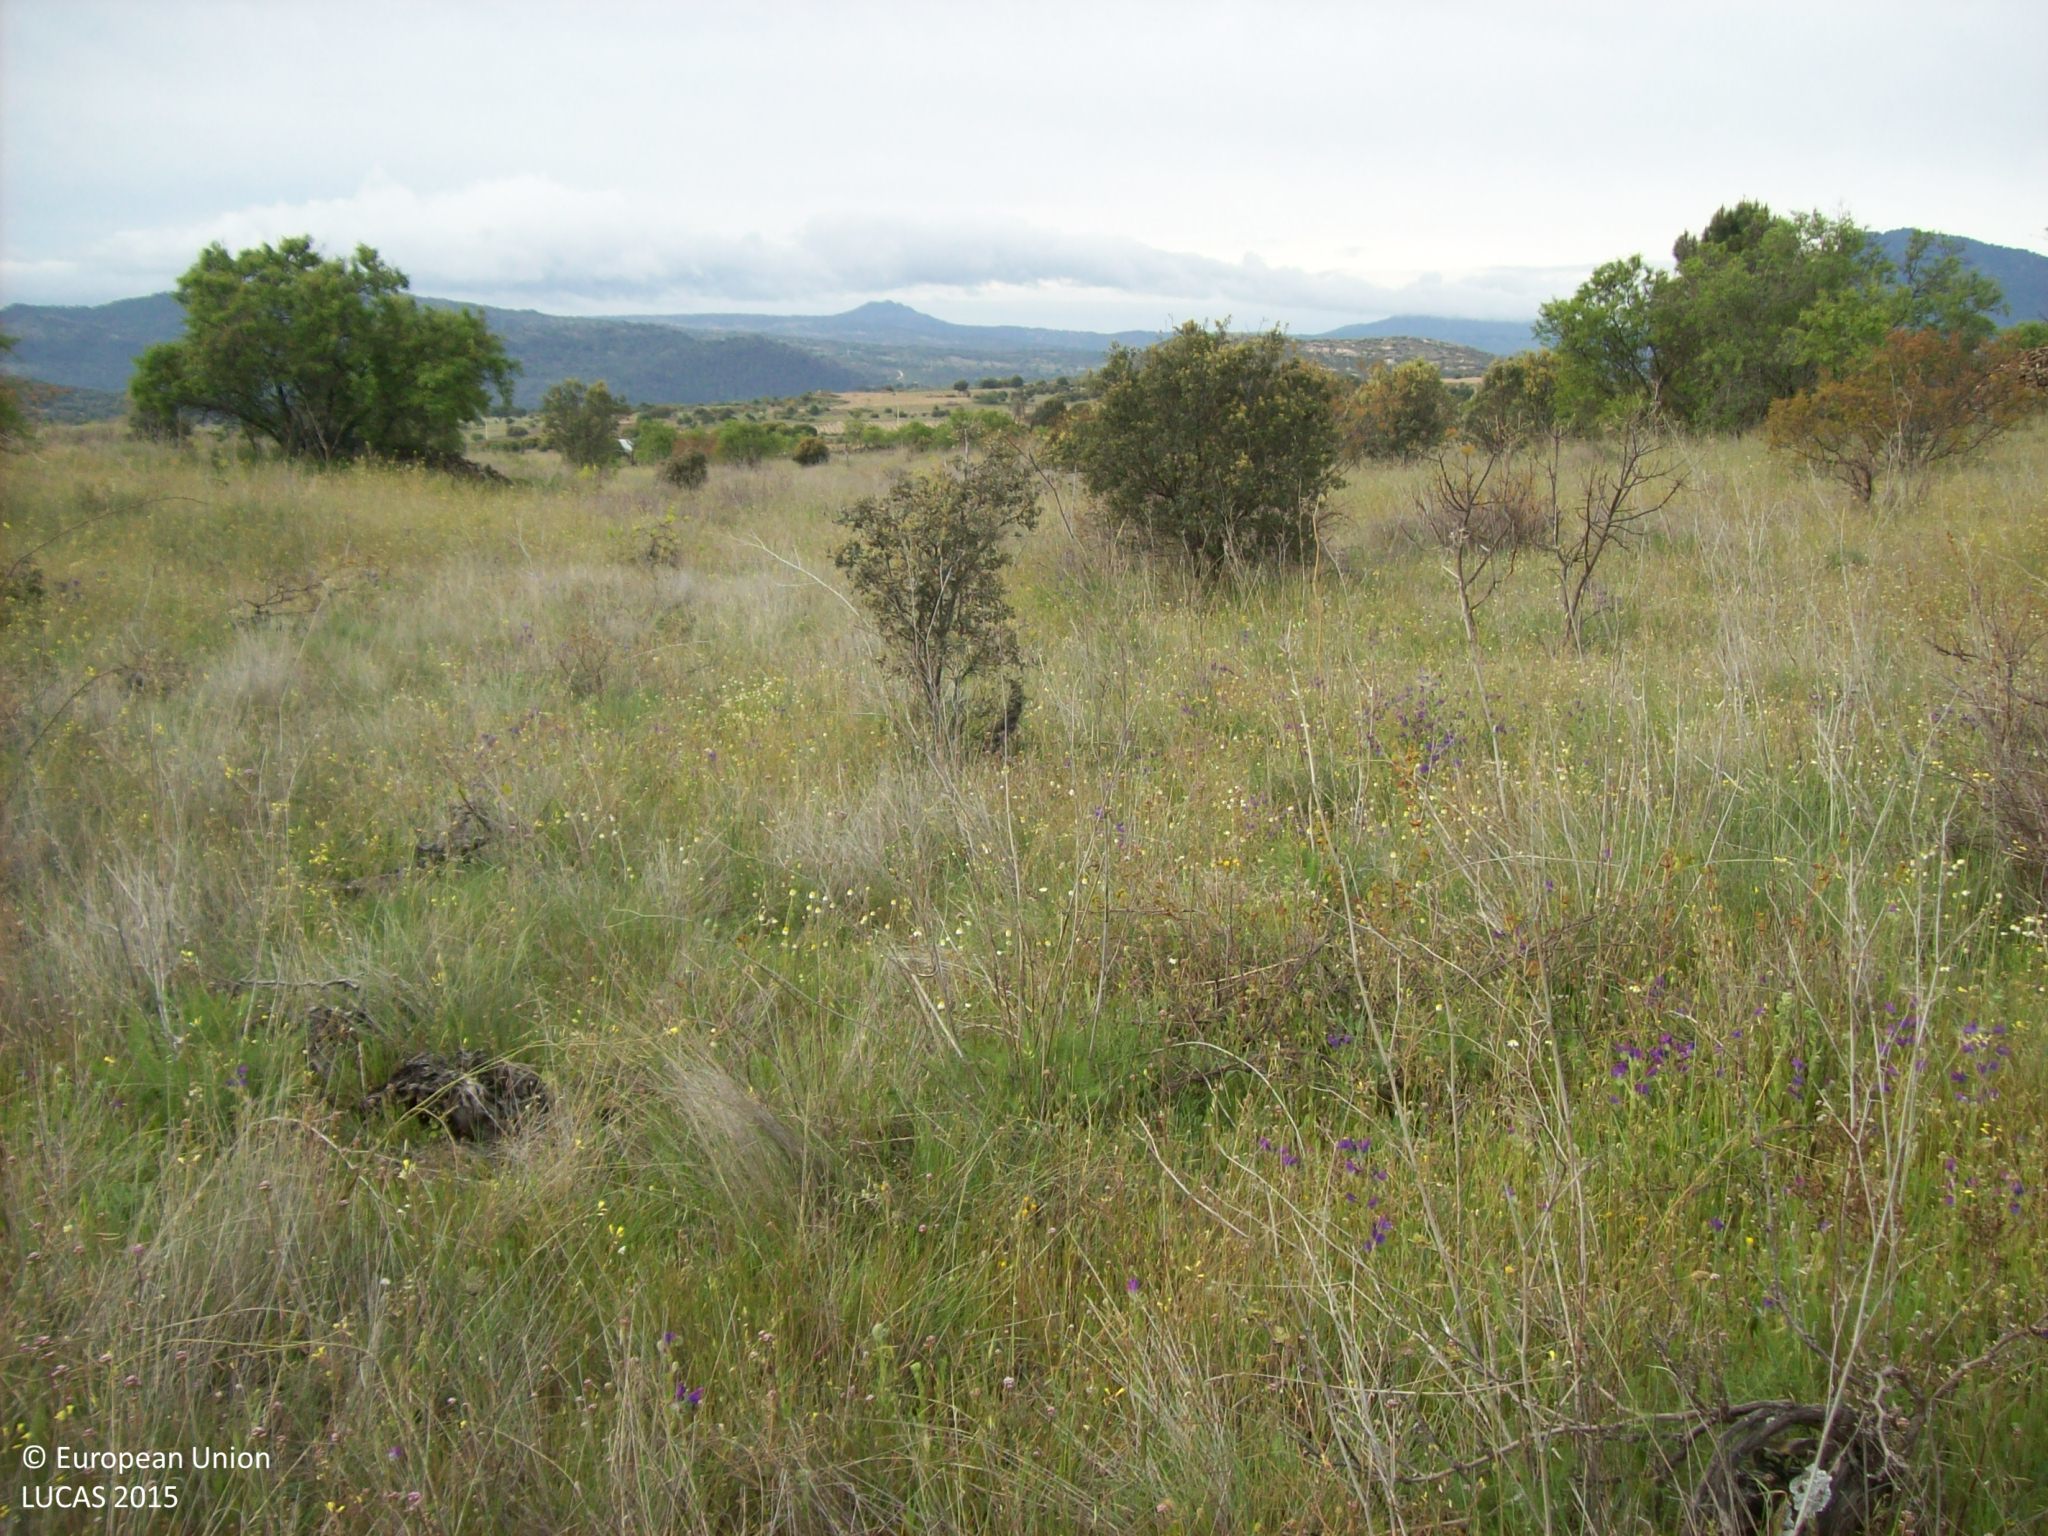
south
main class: Grassland
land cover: Grassland with sparse tree/shrub cover
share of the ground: > 75 %
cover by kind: herbaceous plants 80 %, broadleaved forest trees 5 %, shrubs 5 %, consolidated bare surface 5 %
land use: Abandoned areas
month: April
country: ES
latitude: 40.4431
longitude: -4.4200
